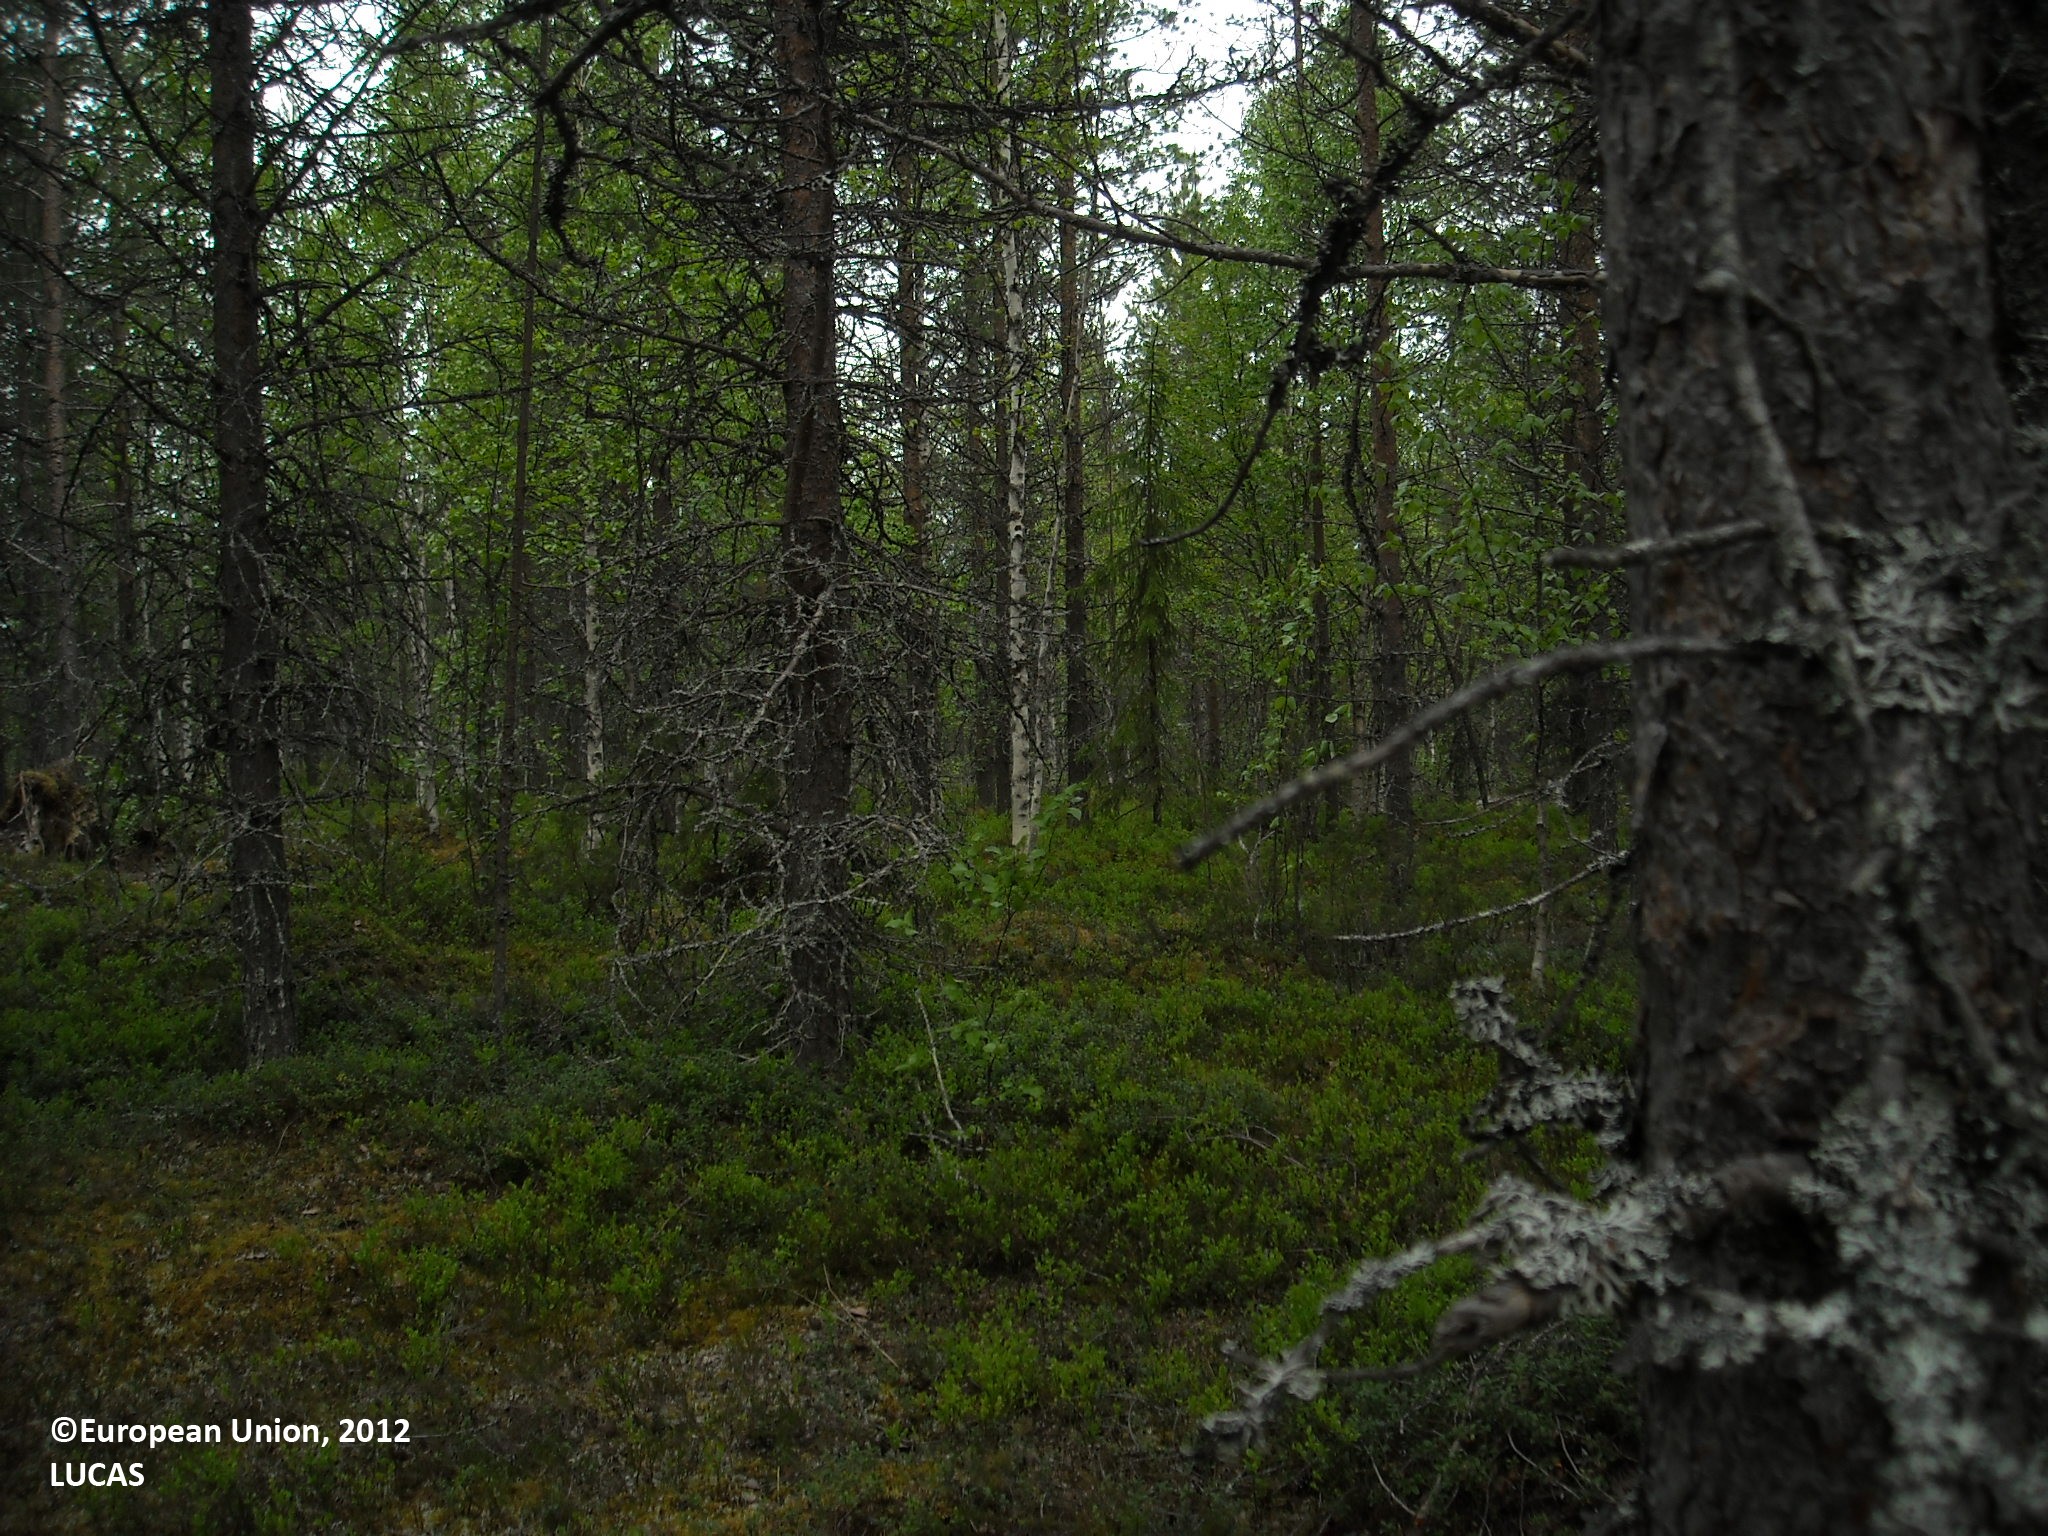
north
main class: Woodland
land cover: Pine dominated mixed woodland
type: boreal forest
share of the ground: > 75 %
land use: Forestry
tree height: > 5 m
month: June
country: FI
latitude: 65.5723
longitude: 28.0233
